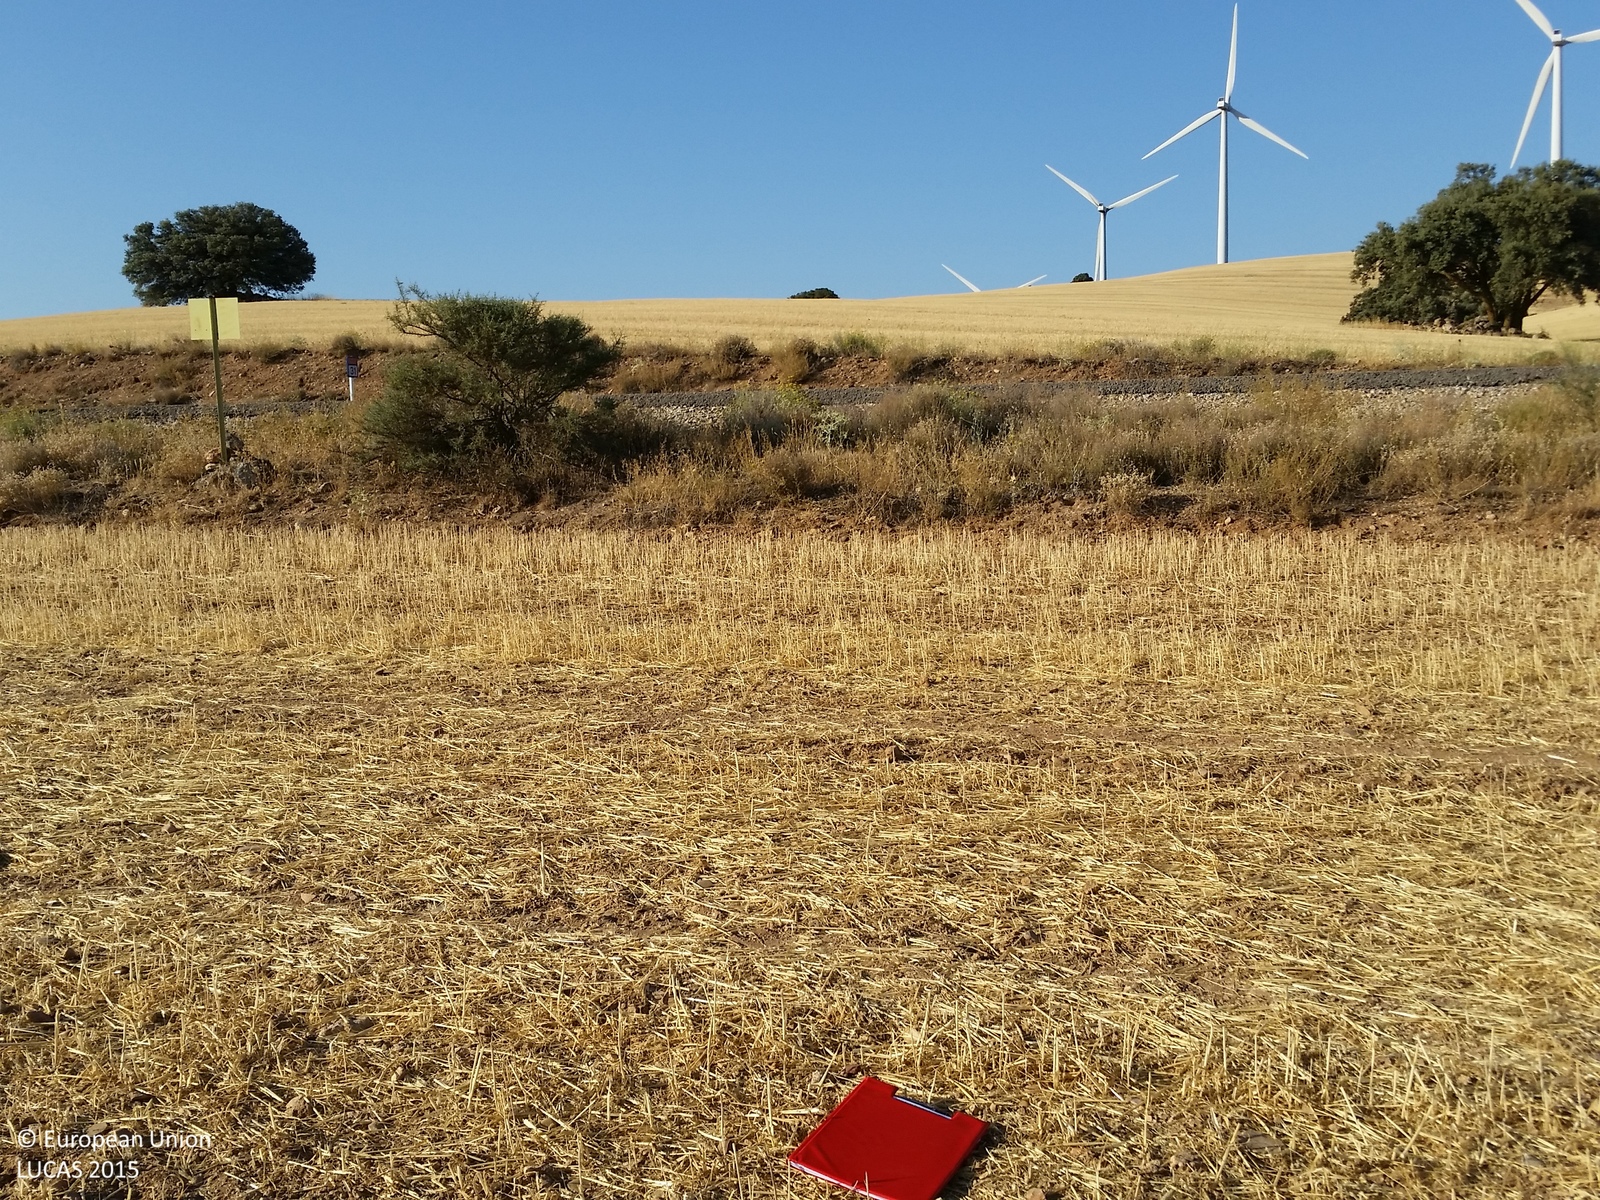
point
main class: Cropland
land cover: Common wheat
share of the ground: < 10 %
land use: Agriculture (excluding fallow land and kitchen gardens)
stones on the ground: 10 - 25 %
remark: Harvested field
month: July
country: ES
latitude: 39.0591
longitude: -2.6620
